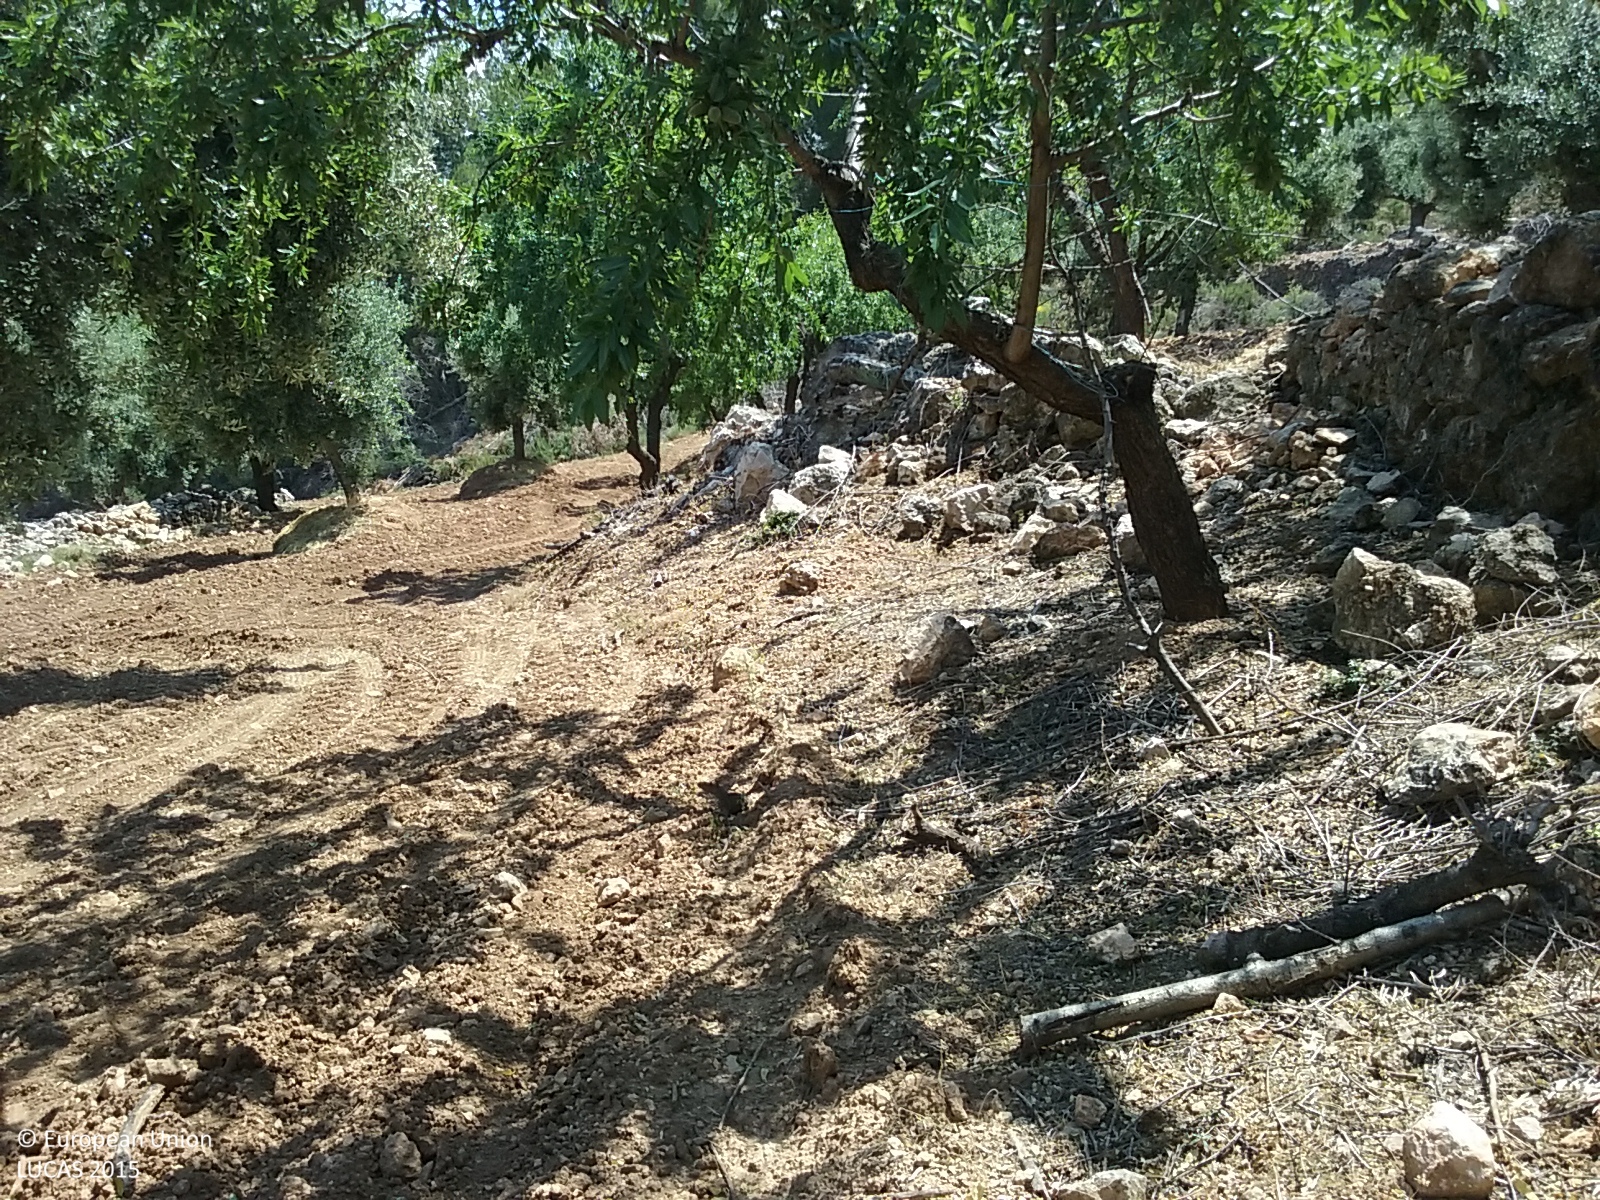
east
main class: Cropland
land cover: Olive groves
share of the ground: 25 - 50 %
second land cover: Other bare soil
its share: > 75 %
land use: Agriculture (excluding fallow land and kitchen gardens)
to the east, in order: Olive groves; Other bare soil; Dry stone walls; Nuts trees; Pine dominated coniferous woodland; Dry stone walls; Pine dominated coniferous woodland; Dry stone walls; Pine dominated coniferous woodland
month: June
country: ES
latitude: 40.8481
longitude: 0.1827
